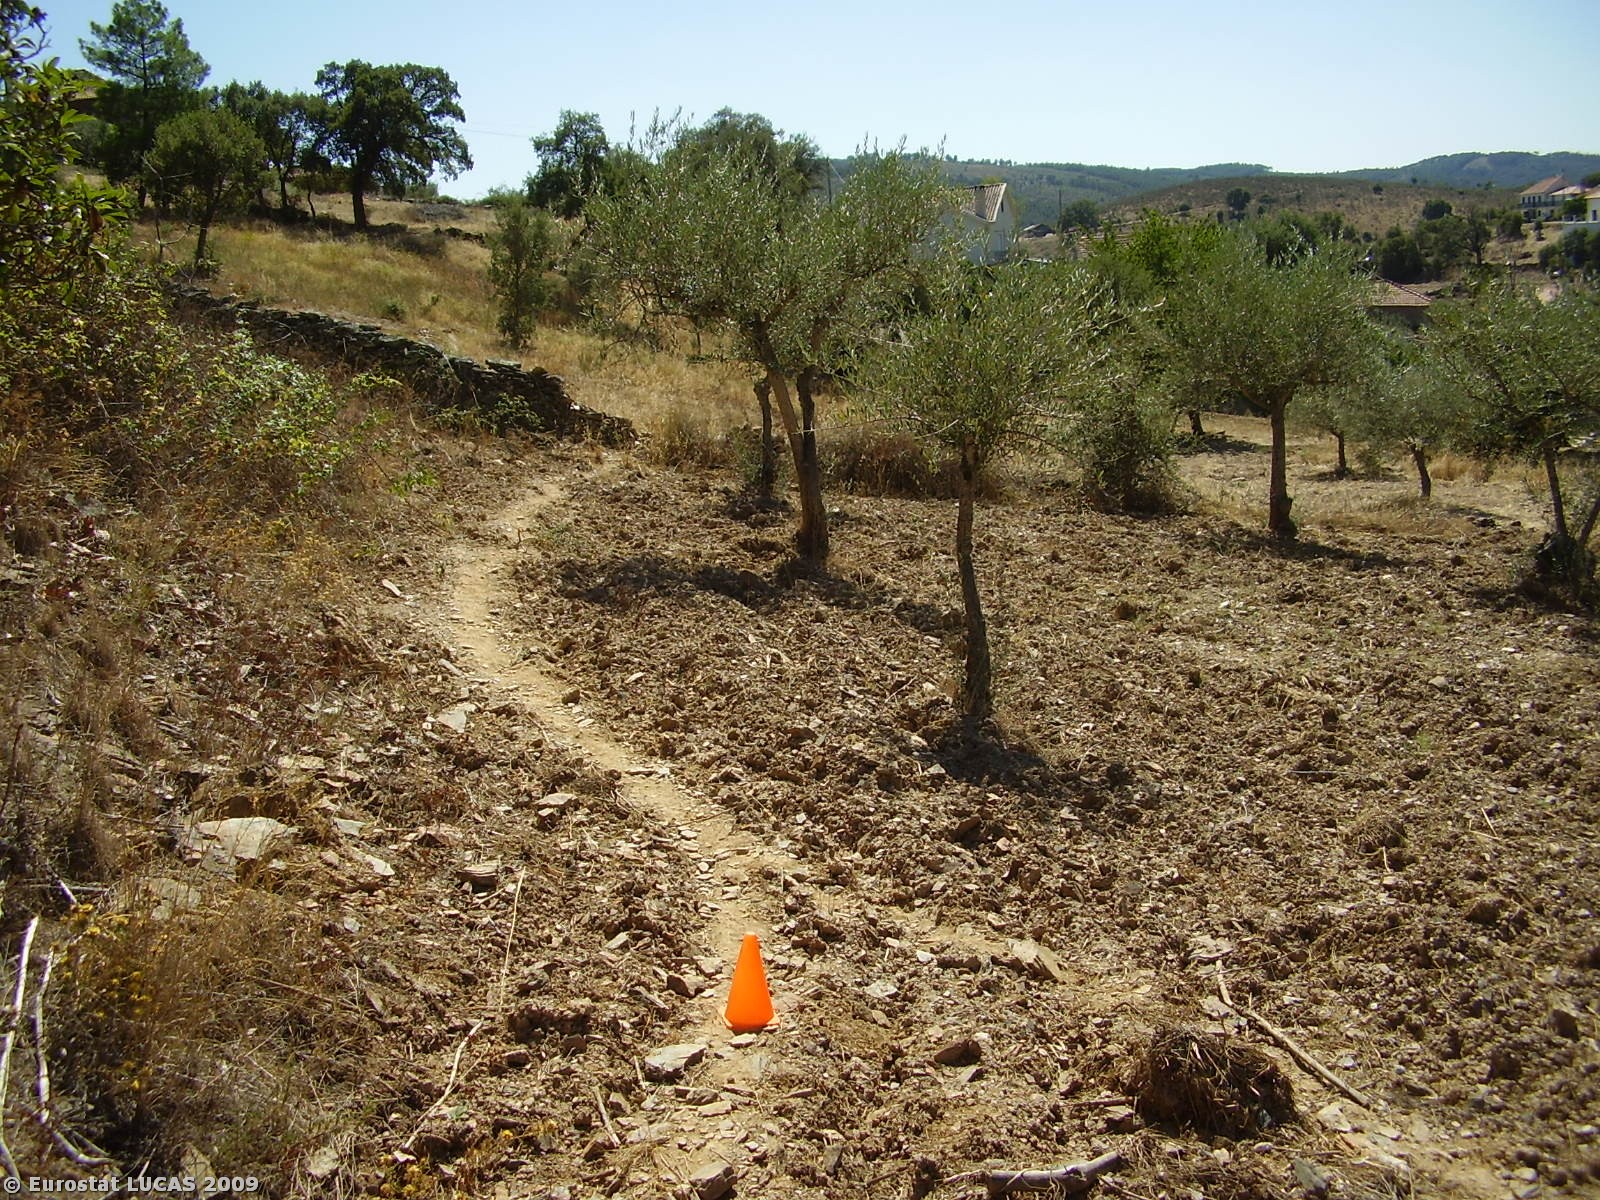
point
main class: Cropland
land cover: Olive groves
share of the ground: 10 - 25 %
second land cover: Spontaneously vegetated surfaces
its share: 10 - 25 %
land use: Agriculture (excluding fallow land and kitchen gardens)
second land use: Fallow land
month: August
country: PT
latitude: 41.2432
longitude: -6.7749
